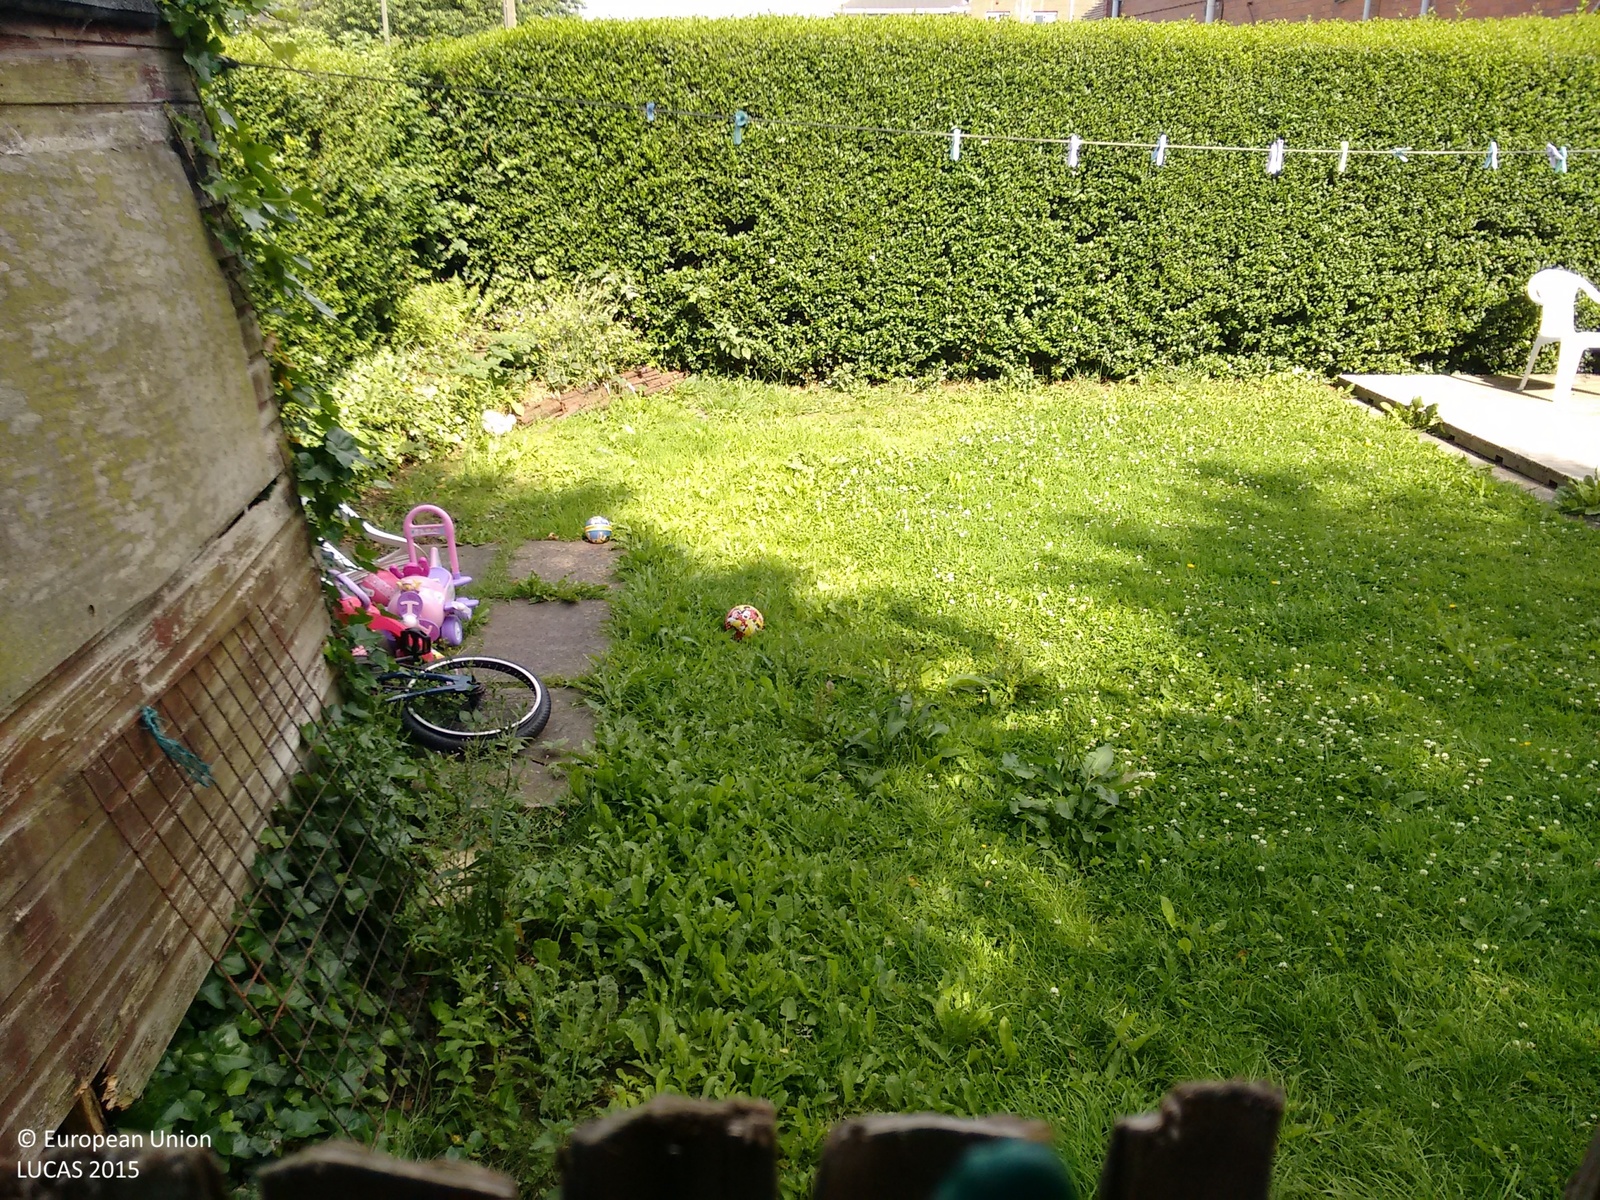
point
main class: Grassland
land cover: Grassland without tree/shrub cover
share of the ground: > 75 %
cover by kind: herbaceous plants 100 %
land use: Residential
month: July
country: GB
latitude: 52.9883
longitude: -2.1413
